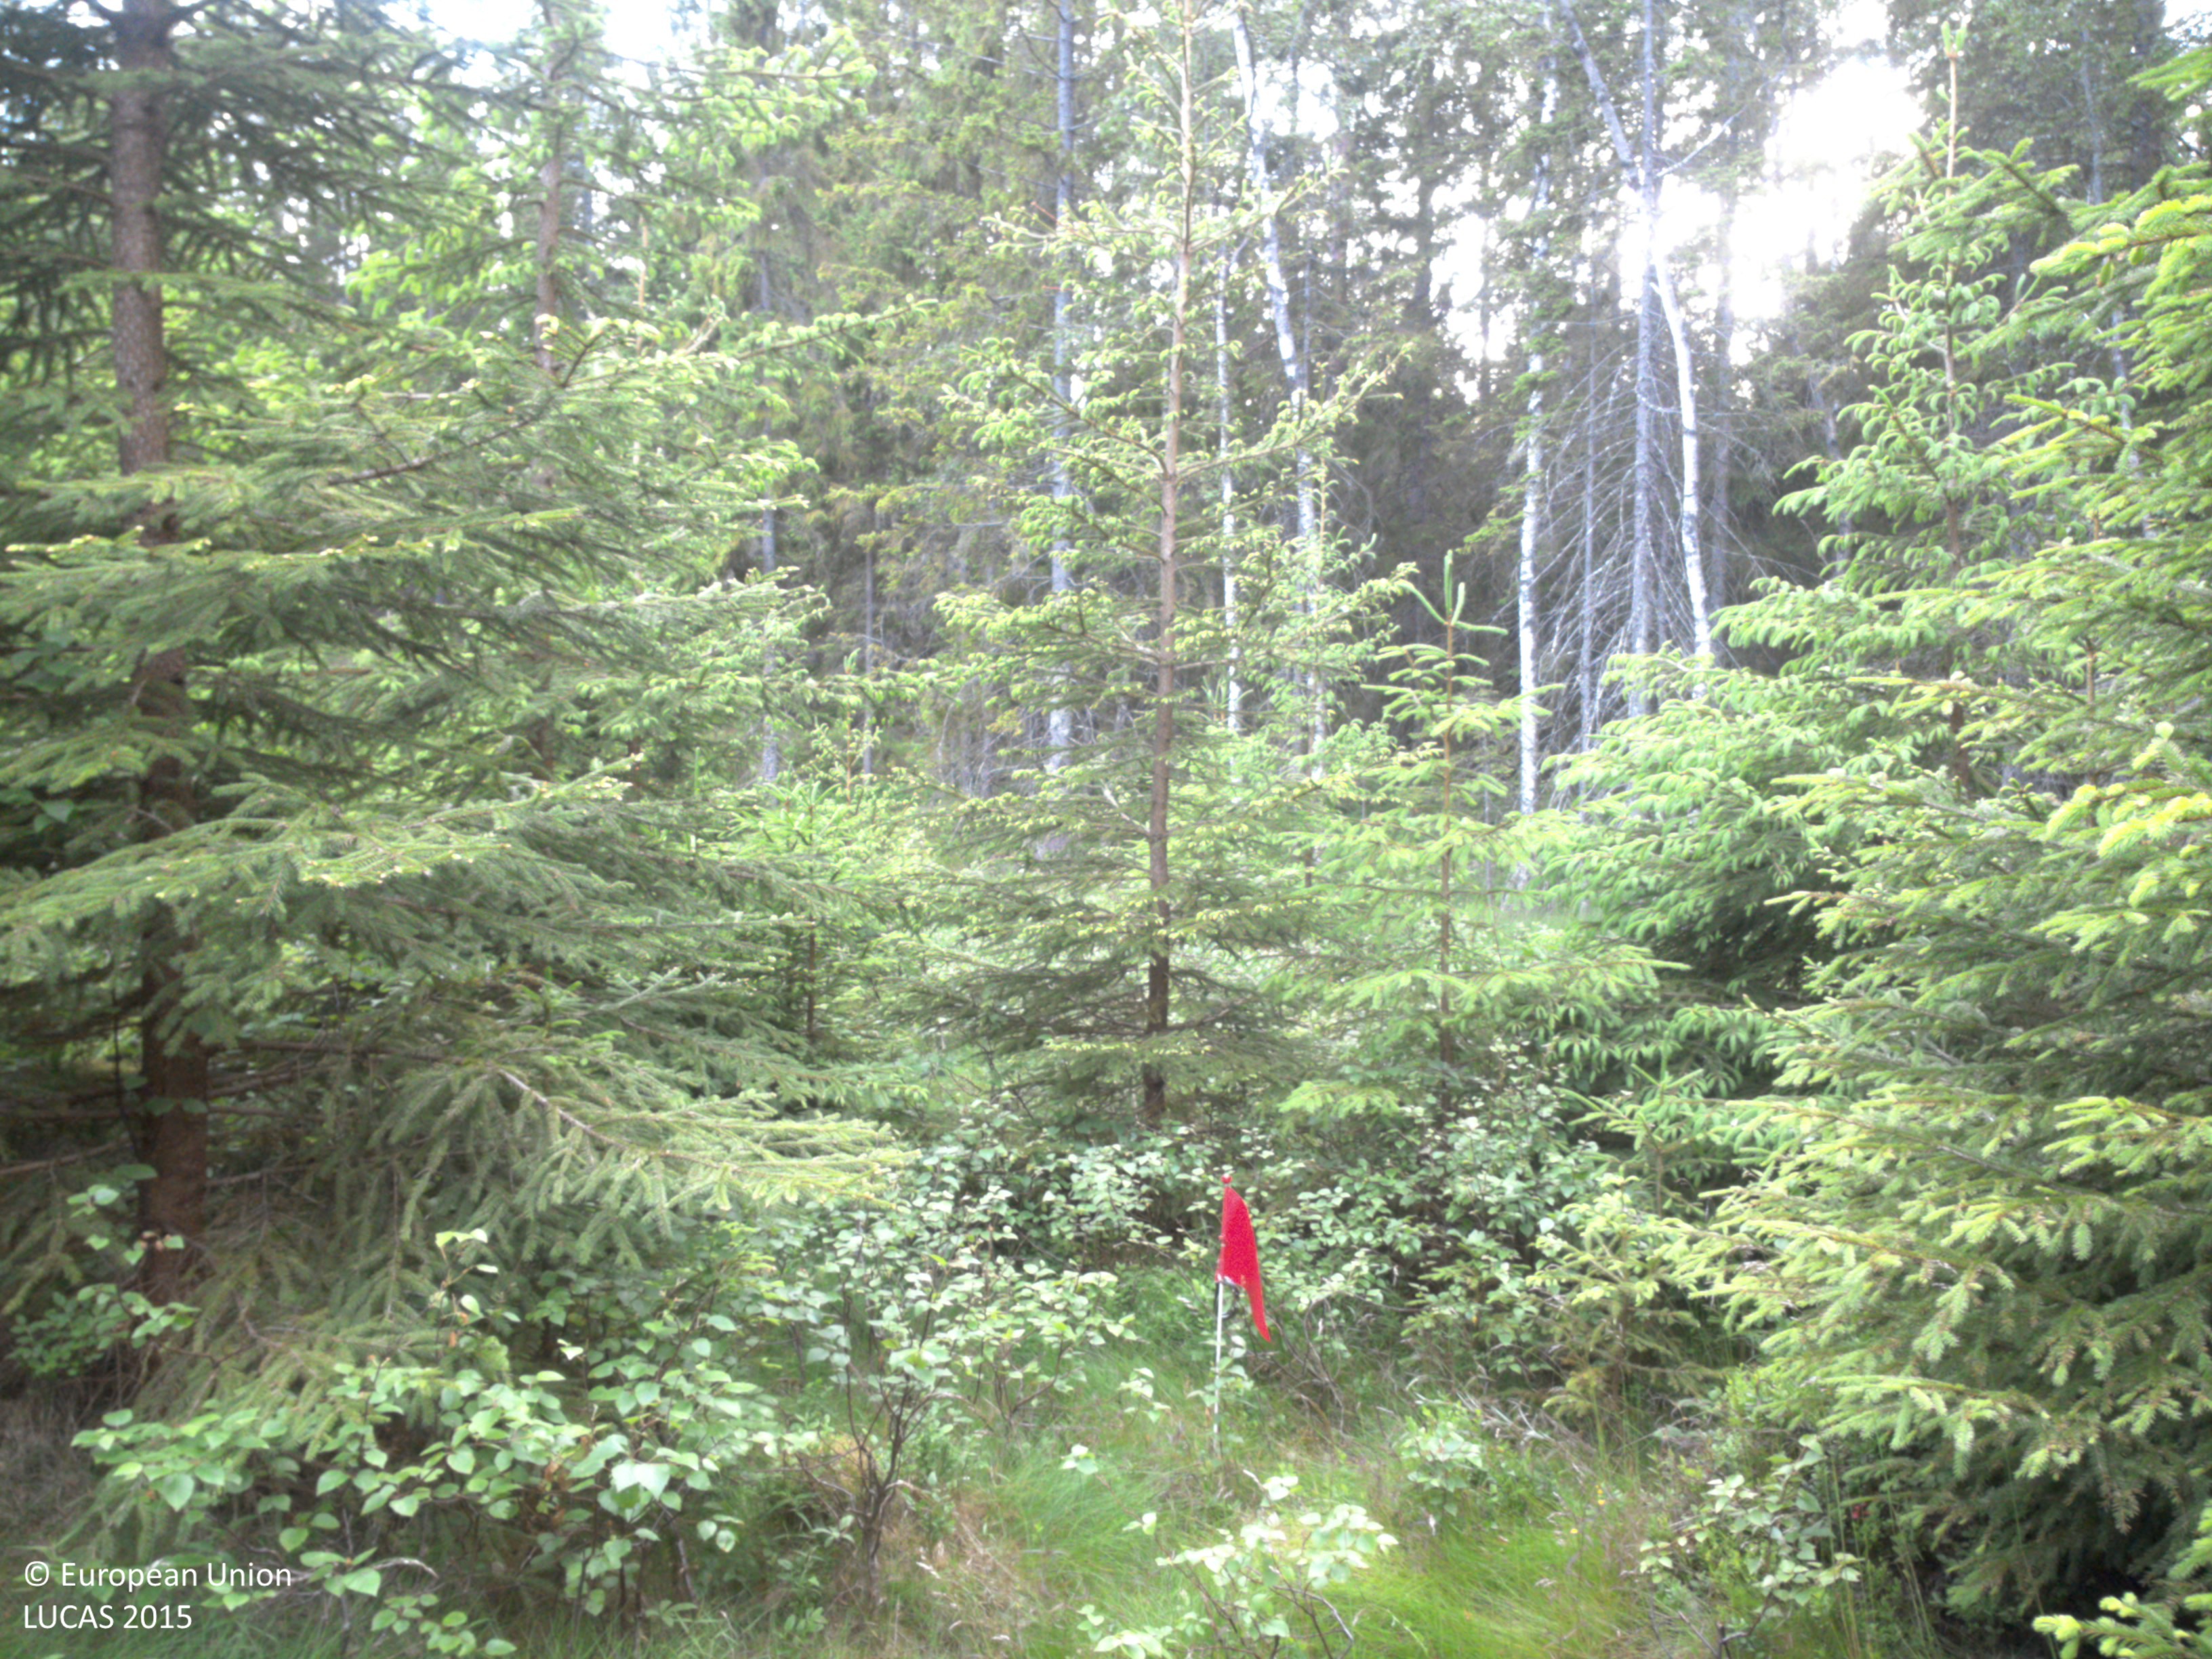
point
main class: Woodland
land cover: Spruce dominated coniferous woodland
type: boreal forest
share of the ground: 50 - 75 %
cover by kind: coniferous forest trees 55 %, herbaceous plants 40 %, broadleaved forest trees 5 %
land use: Forestry
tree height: > 5 m
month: June
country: SE
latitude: 58.8662
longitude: 12.2665
